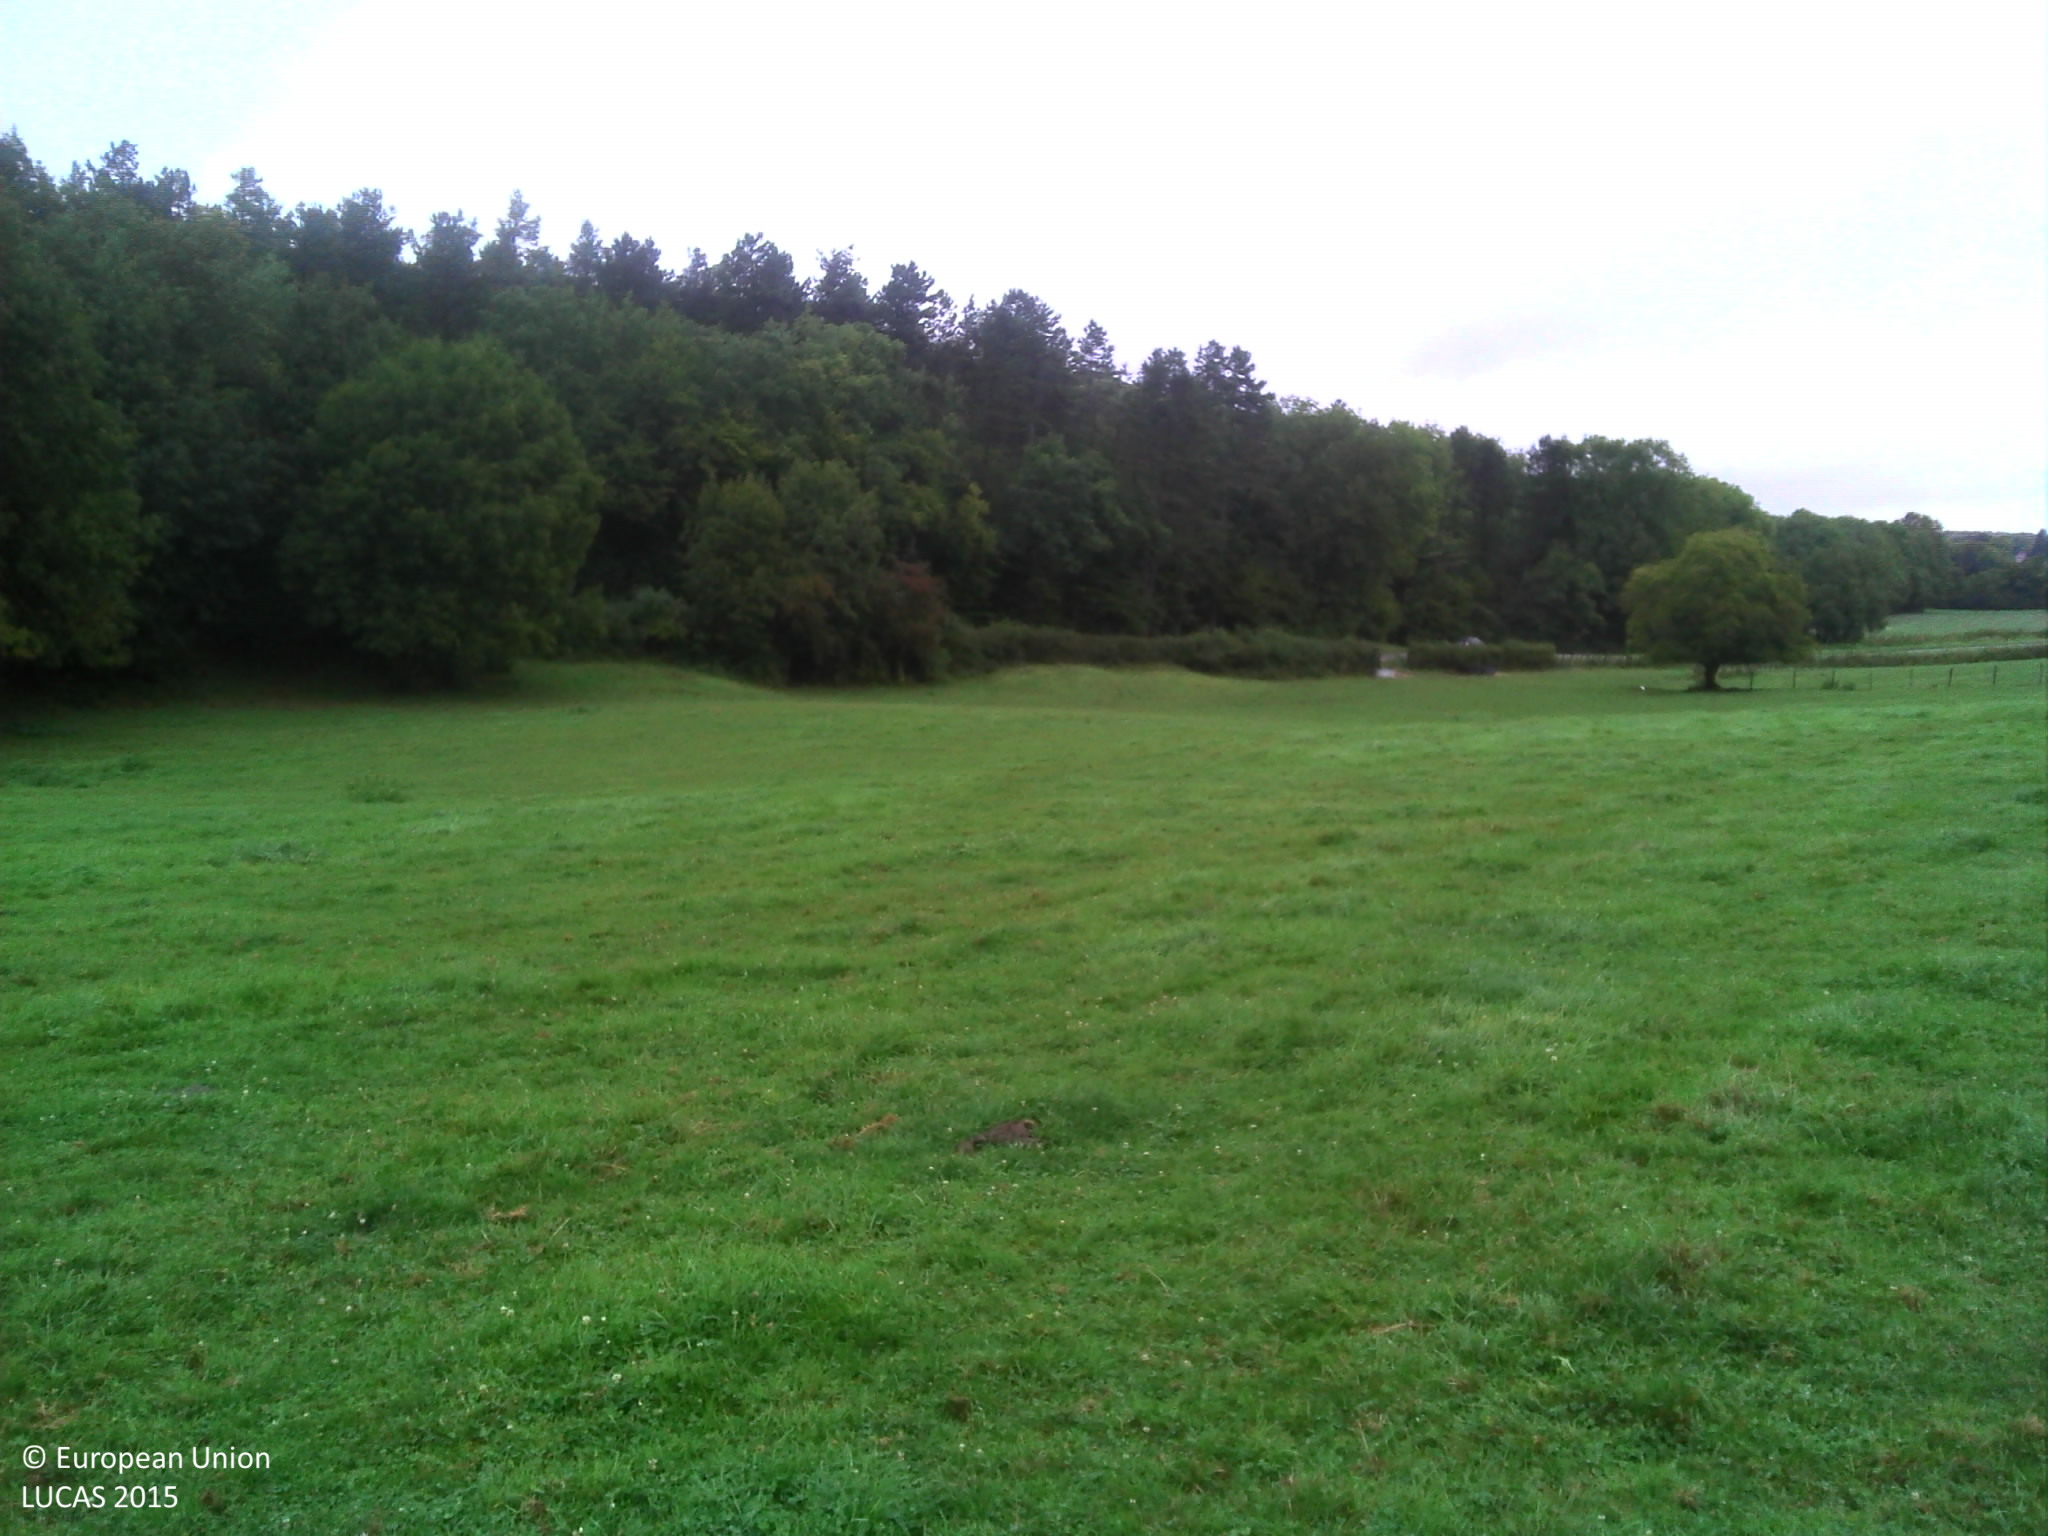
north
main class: Grassland
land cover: Grassland without tree/shrub cover
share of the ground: > 75 %
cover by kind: herbaceous plants 90 %, consolidated bare surface 10 %
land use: Agriculture (excluding fallow land and kitchen gardens)
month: September
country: FR
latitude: 47.1648
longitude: 6.1368
